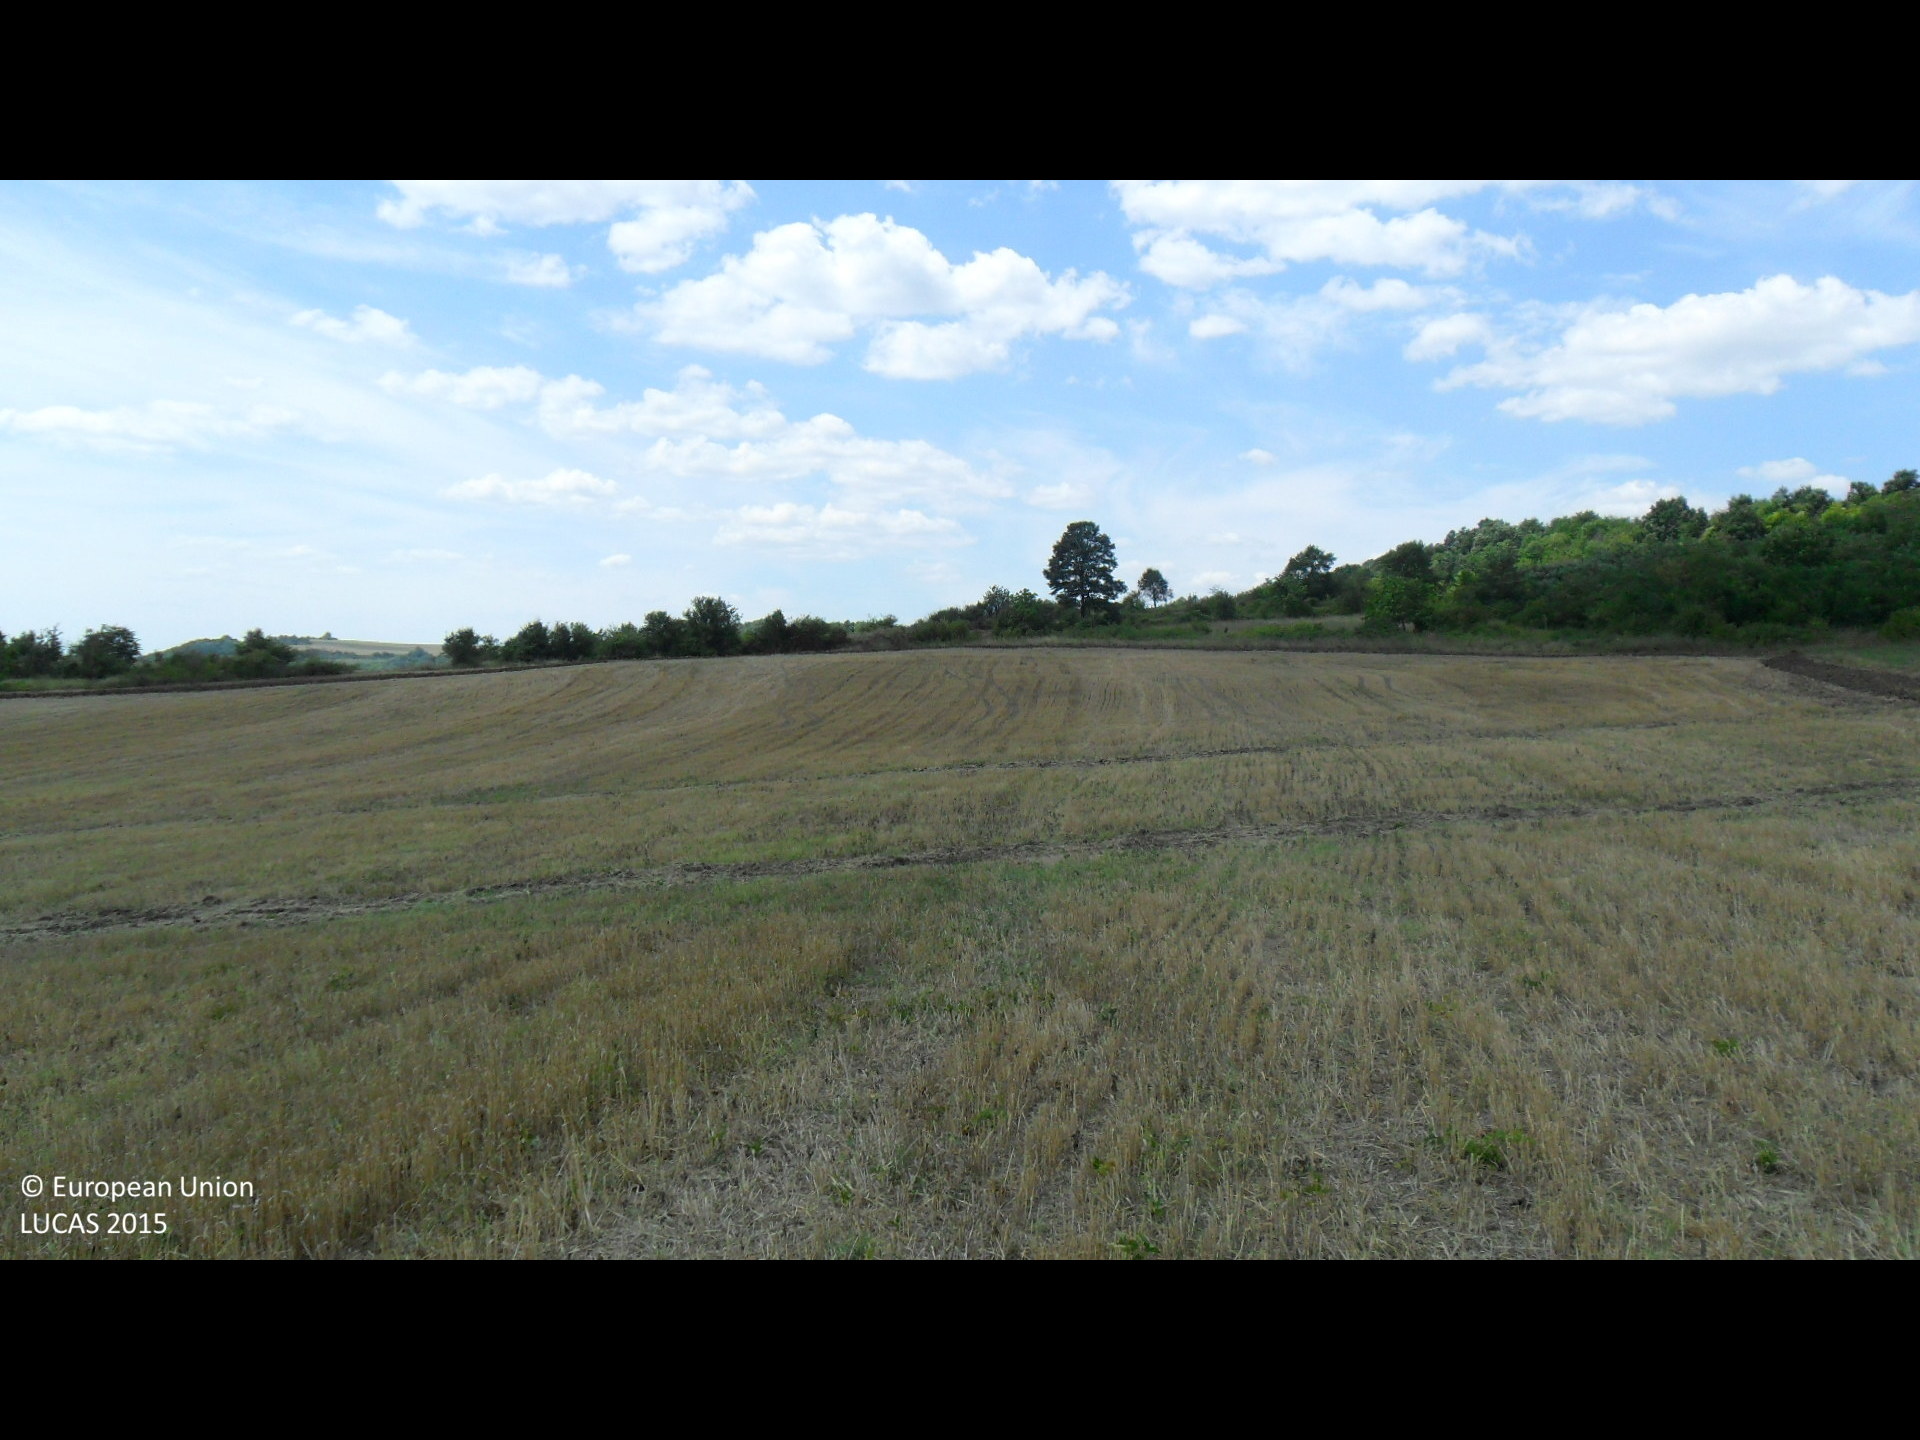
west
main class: Cropland
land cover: Barley
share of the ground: > 75 %
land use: Agriculture (excluding fallow land and kitchen gardens)
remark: Harvested field
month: August
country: BG
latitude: 43.3615
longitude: 26.4261
